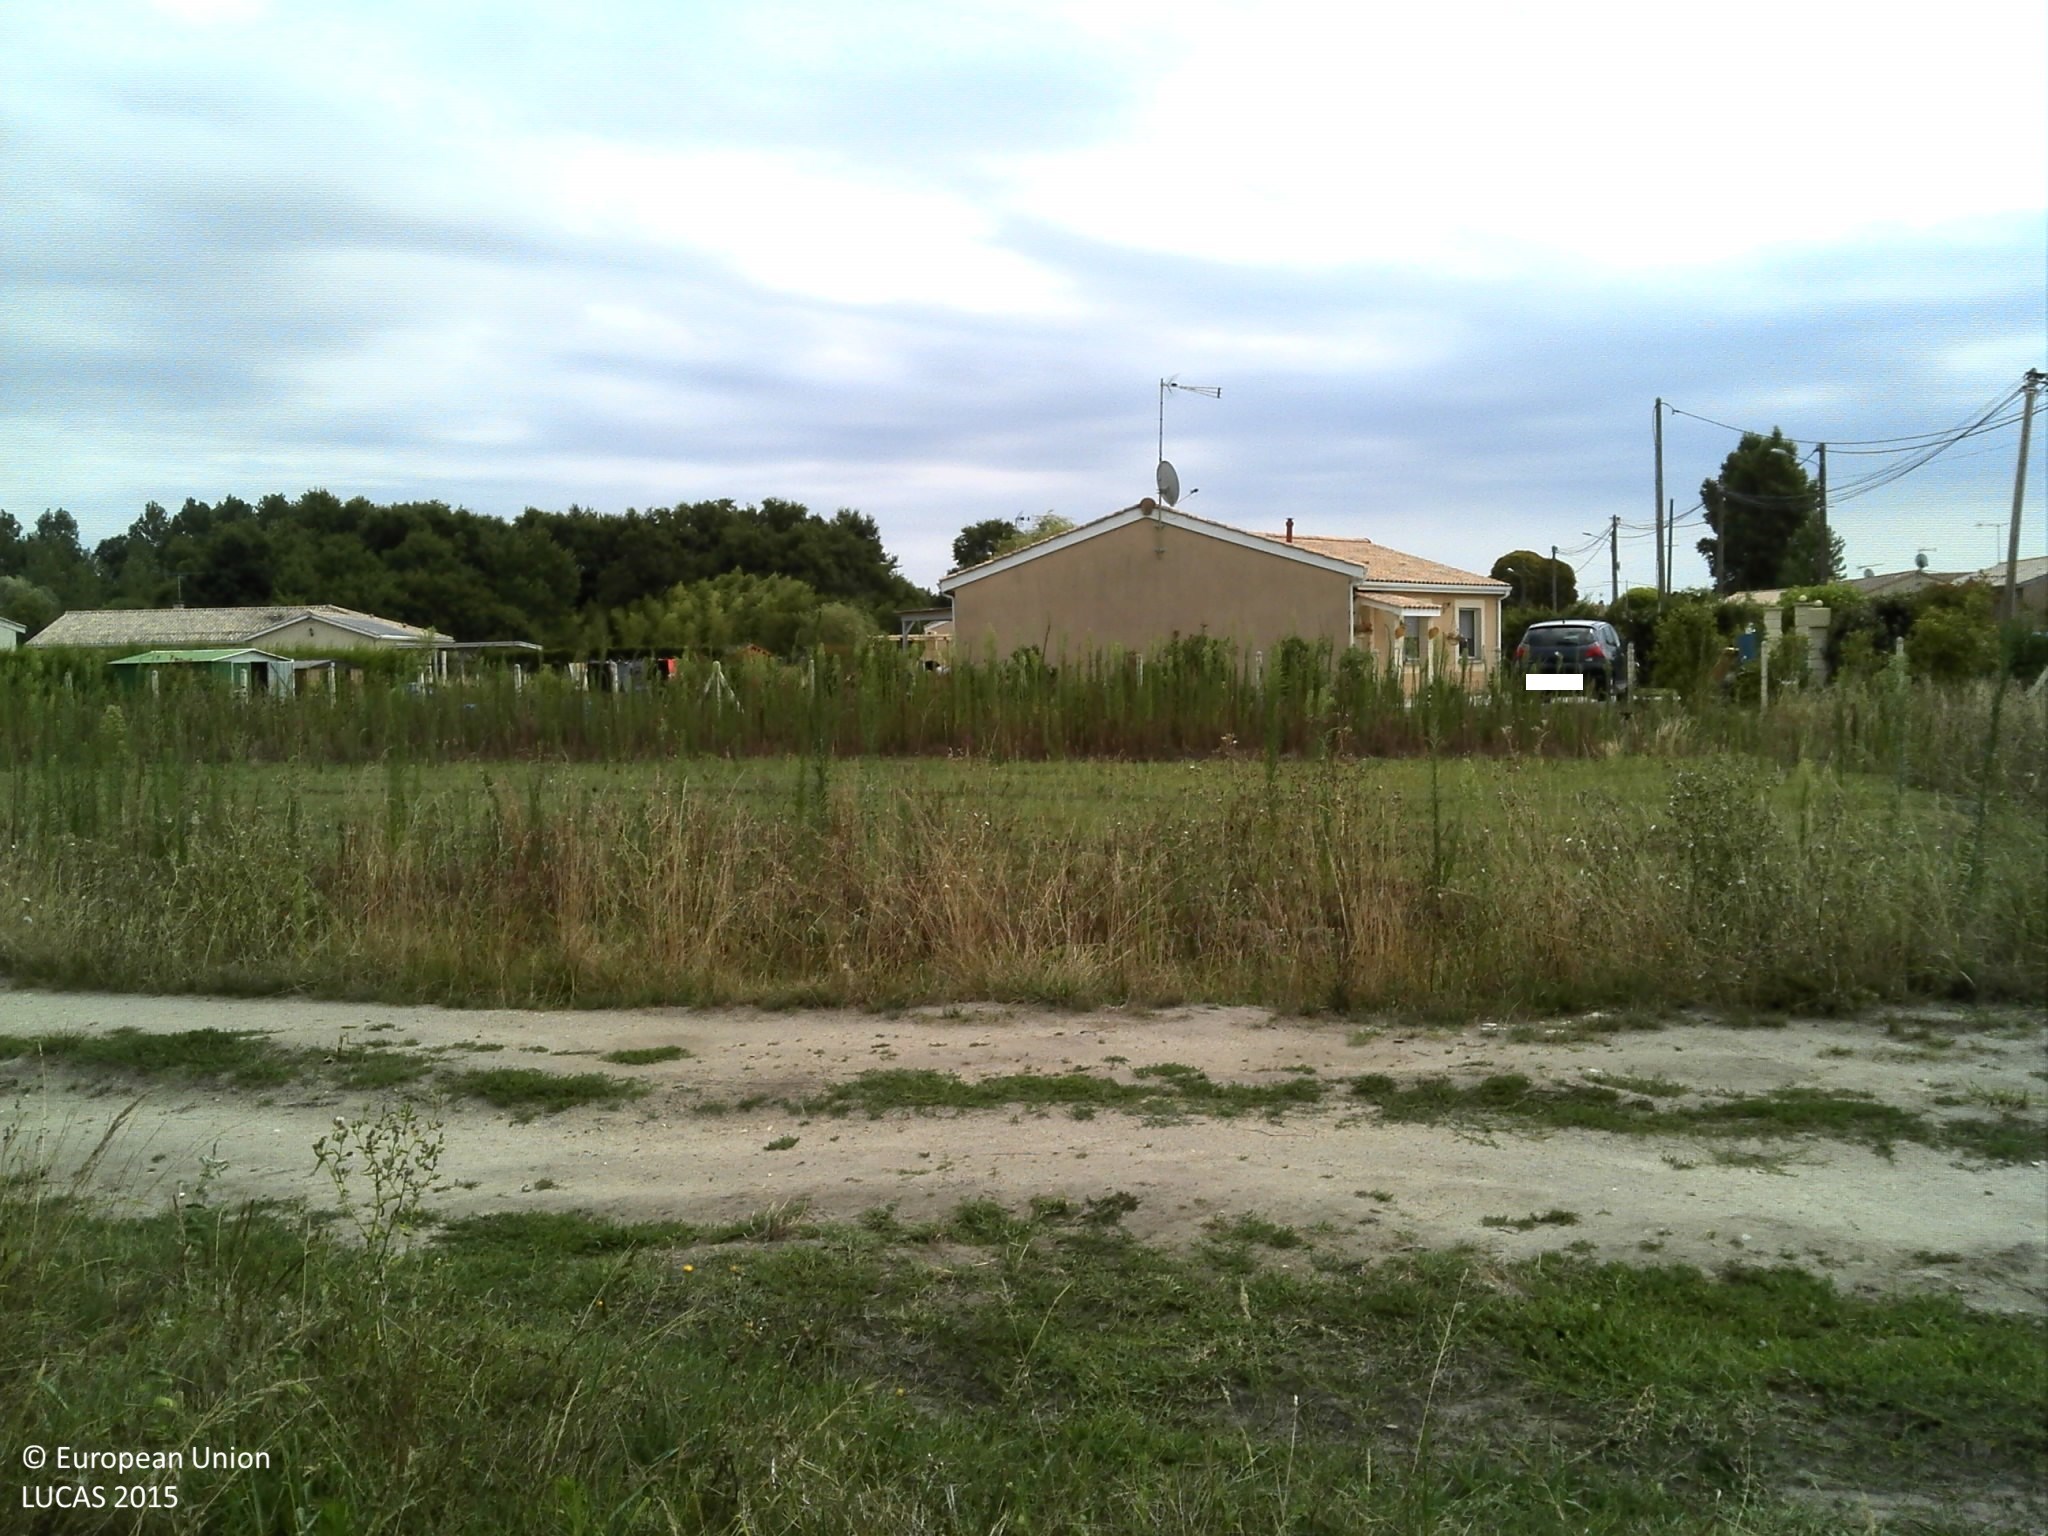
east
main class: Woodland
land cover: Broadleaved woodland
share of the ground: > 75 %
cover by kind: broadleaved forest trees 70 %, shrubs 30 %
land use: Semi-natural and natural areas not in use
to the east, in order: Broadleaved woodland; Tracks; Grassland without tree/shrub cover; Artificial constructions in urban areas; Grassland without tree/shrub cover; Artificial constructions in urban areas; Grassland without tree/shrub cover; Tracks; Fences; Grassland without tree/shrub cover; Fences; Broadleaved woodland; Grassland without tree/shrub cover; Broadleaved woodland; Grassland without tree/shrub cover
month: August
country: FR
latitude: 45.2054
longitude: -0.6007
